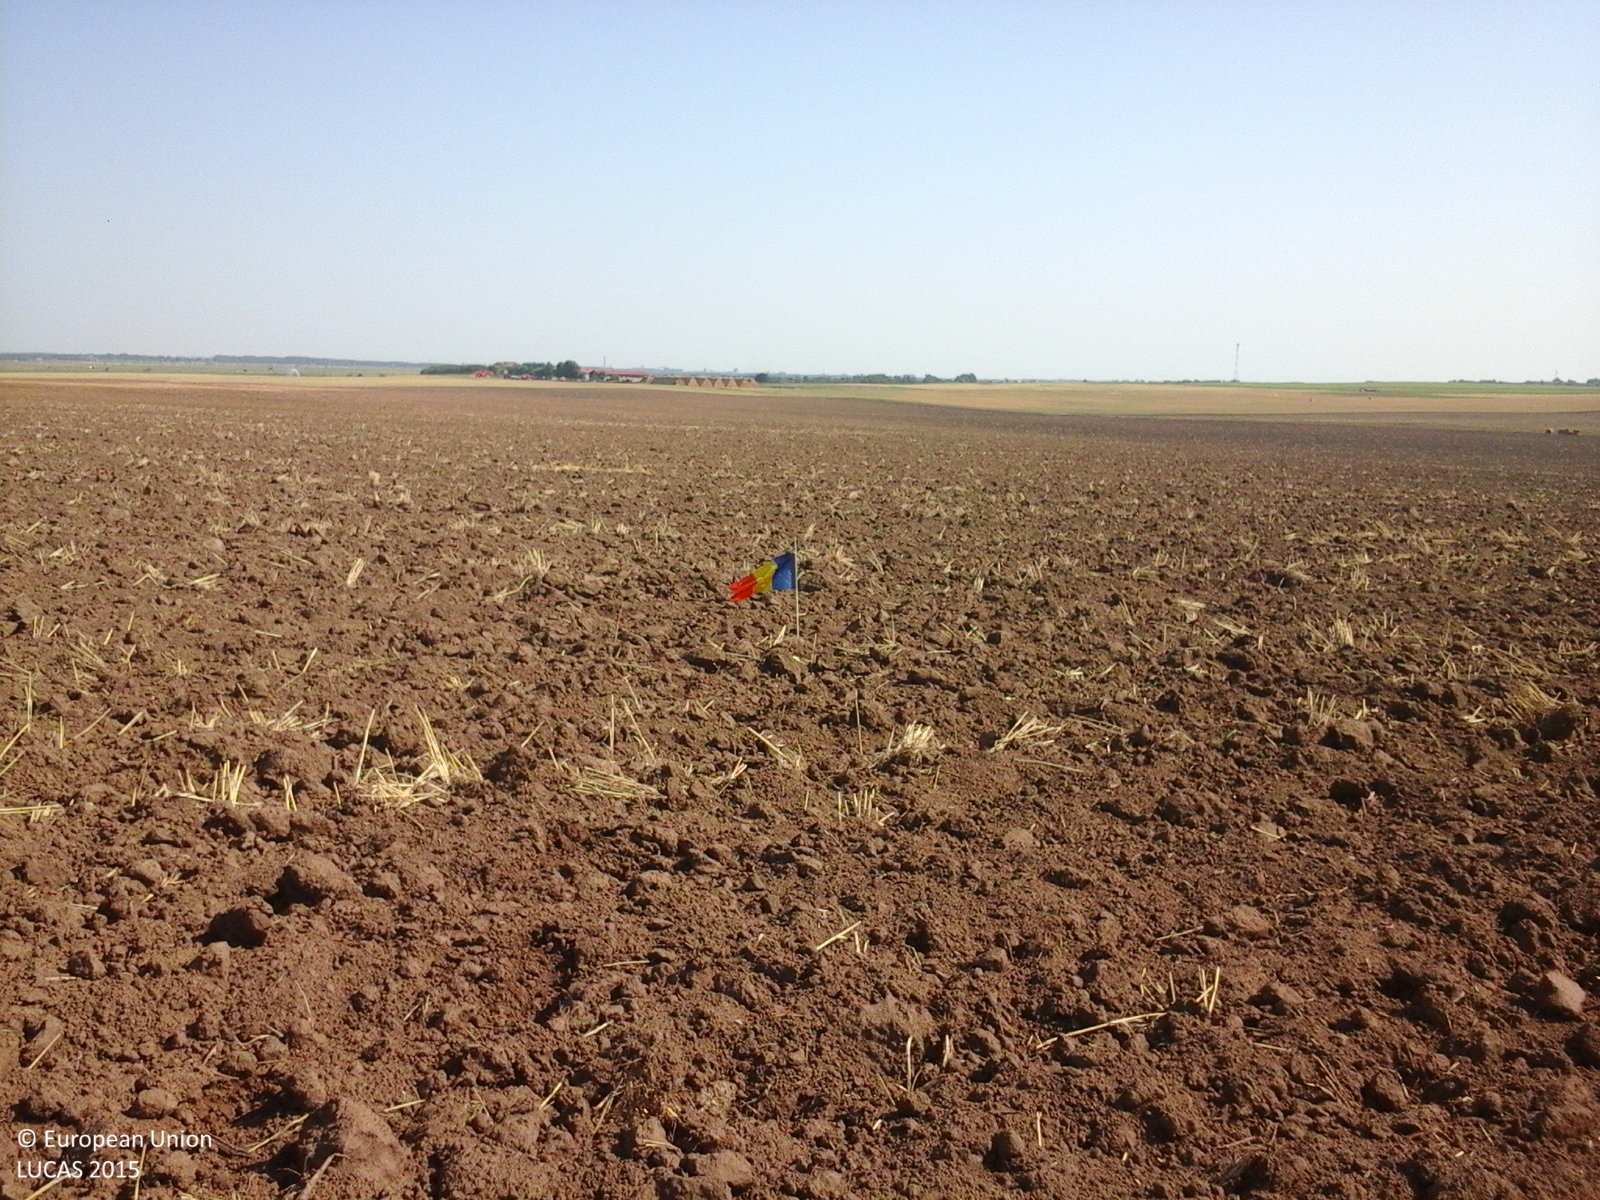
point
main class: Cropland
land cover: Common wheat
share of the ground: < 10 %
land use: Agriculture (excluding fallow land and kitchen gardens)
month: July
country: RO
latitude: 44.5795
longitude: 27.6152
